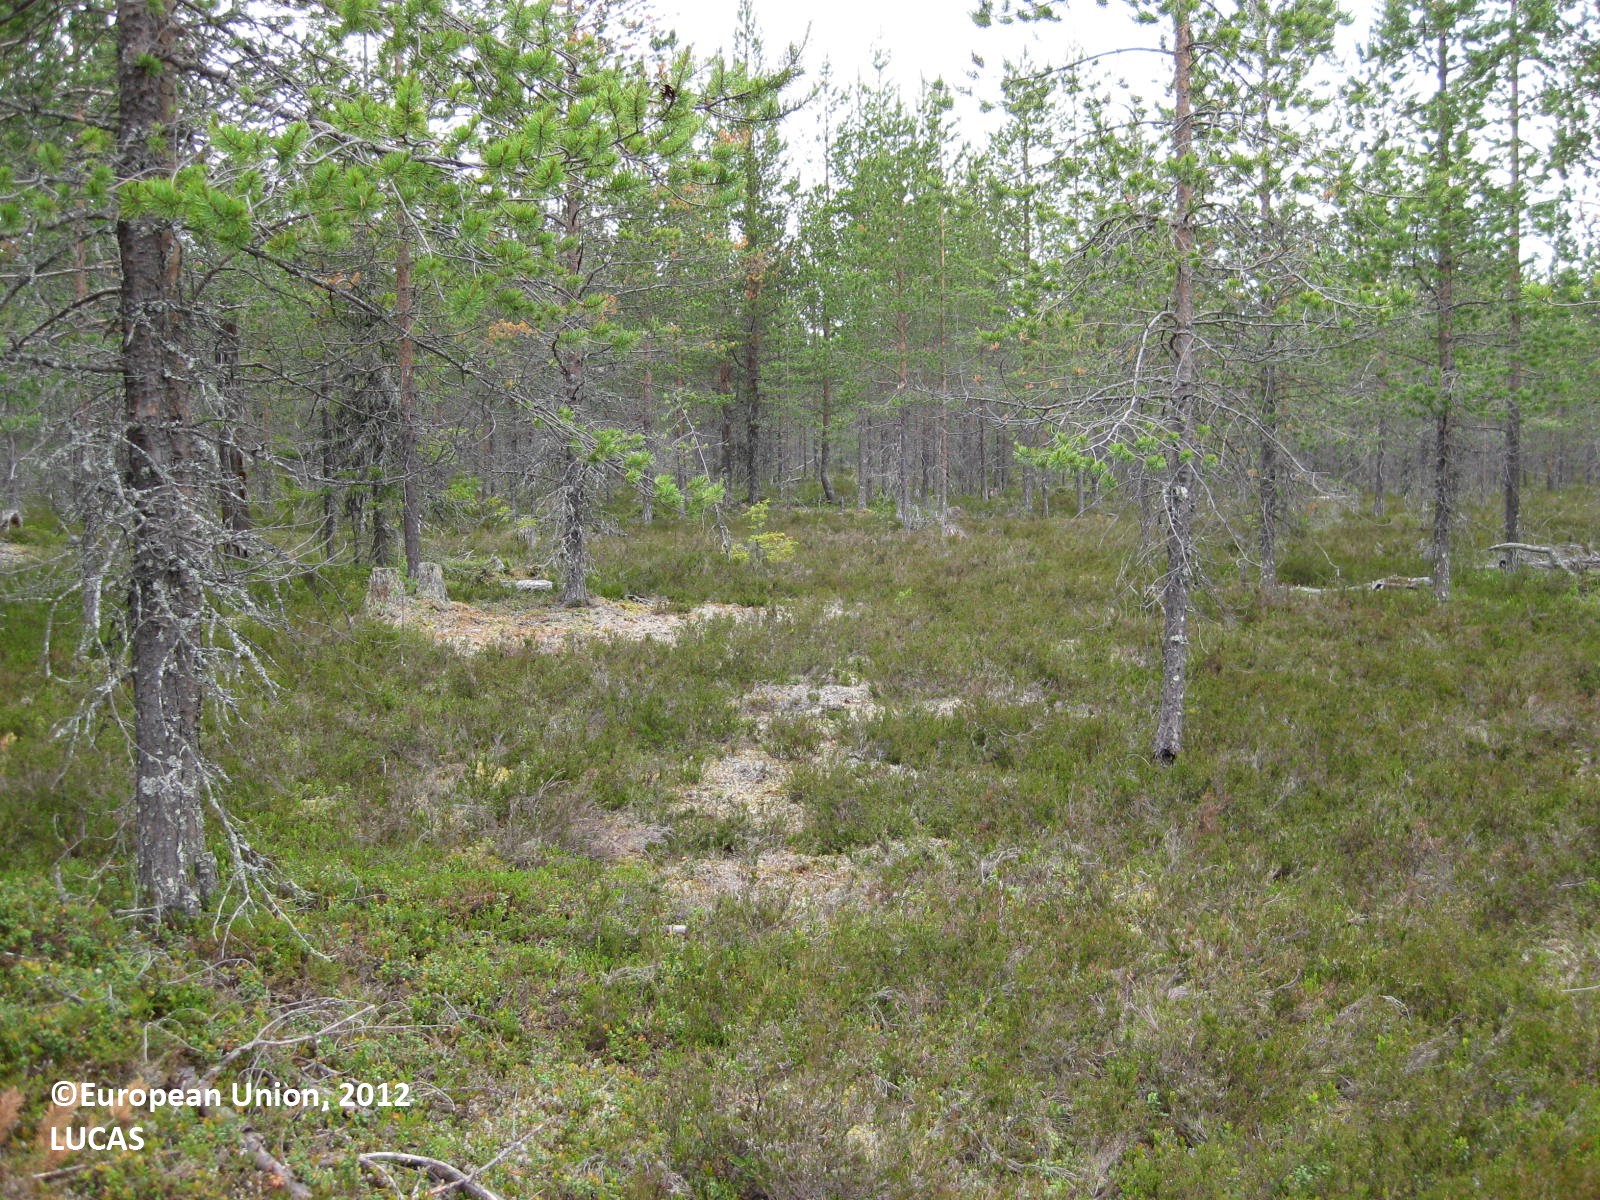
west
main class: Woodland
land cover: Pine dominated coniferous woodland
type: boreal forest
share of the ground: 25 - 50 %
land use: Forestry
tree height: > 5 m
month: July
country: FI
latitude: 65.5988
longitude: 29.2558
